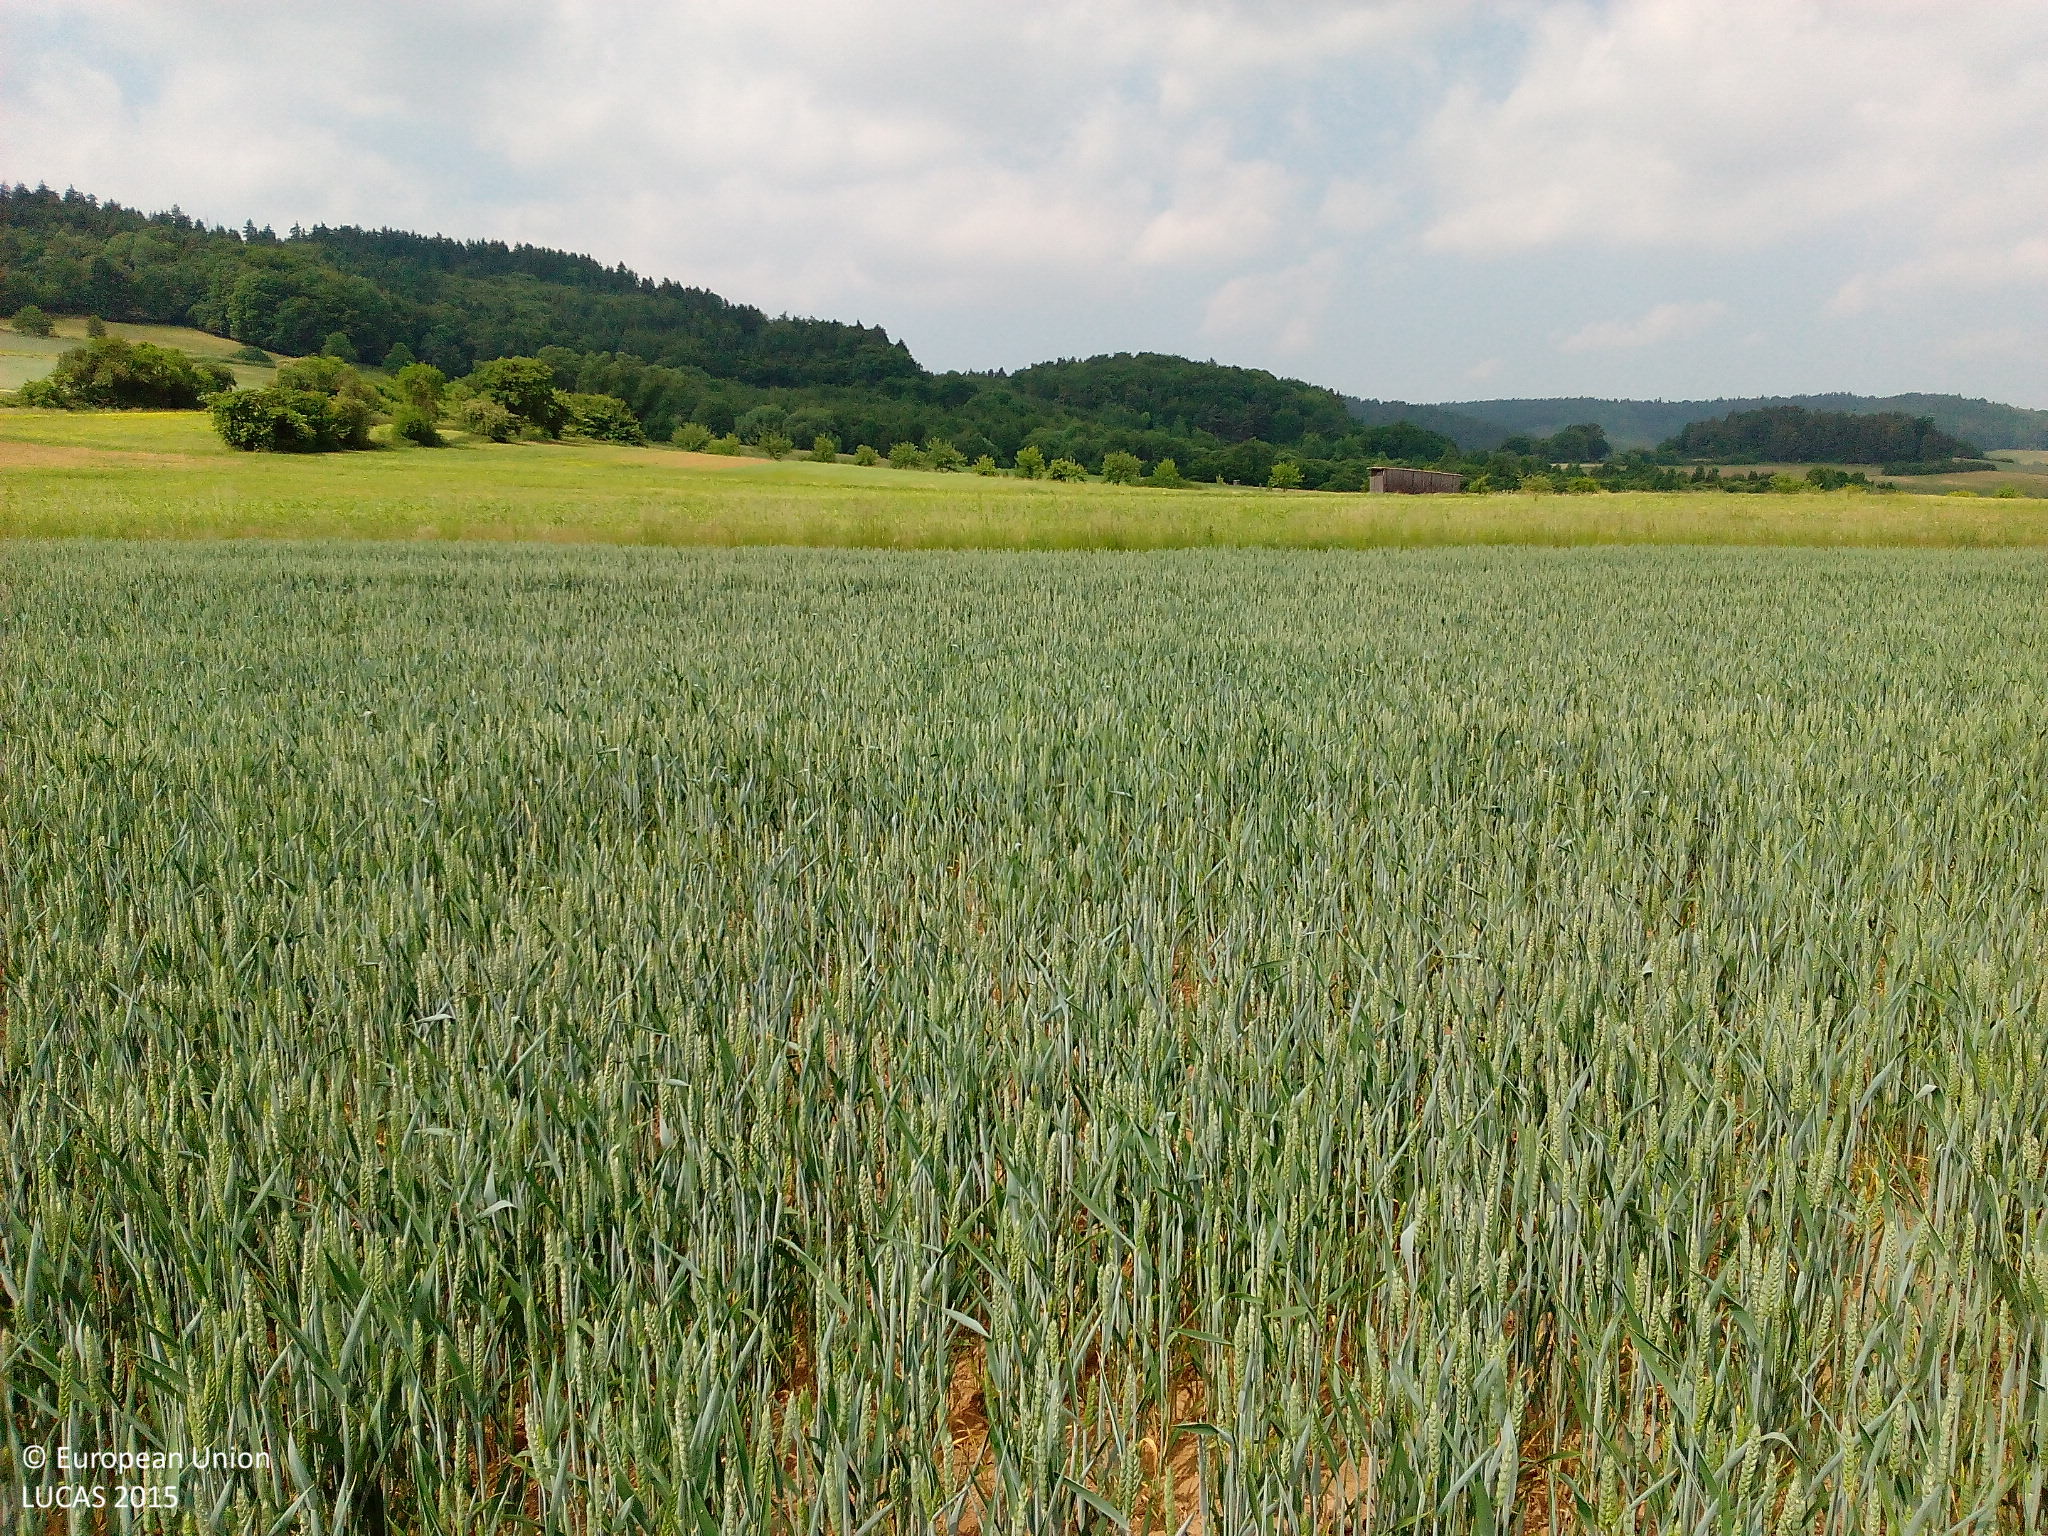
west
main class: Cropland
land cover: Common wheat
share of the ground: > 75 %
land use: Agriculture (excluding fallow land and kitchen gardens)
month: June
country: DE
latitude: 51.0108
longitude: 9.6438
